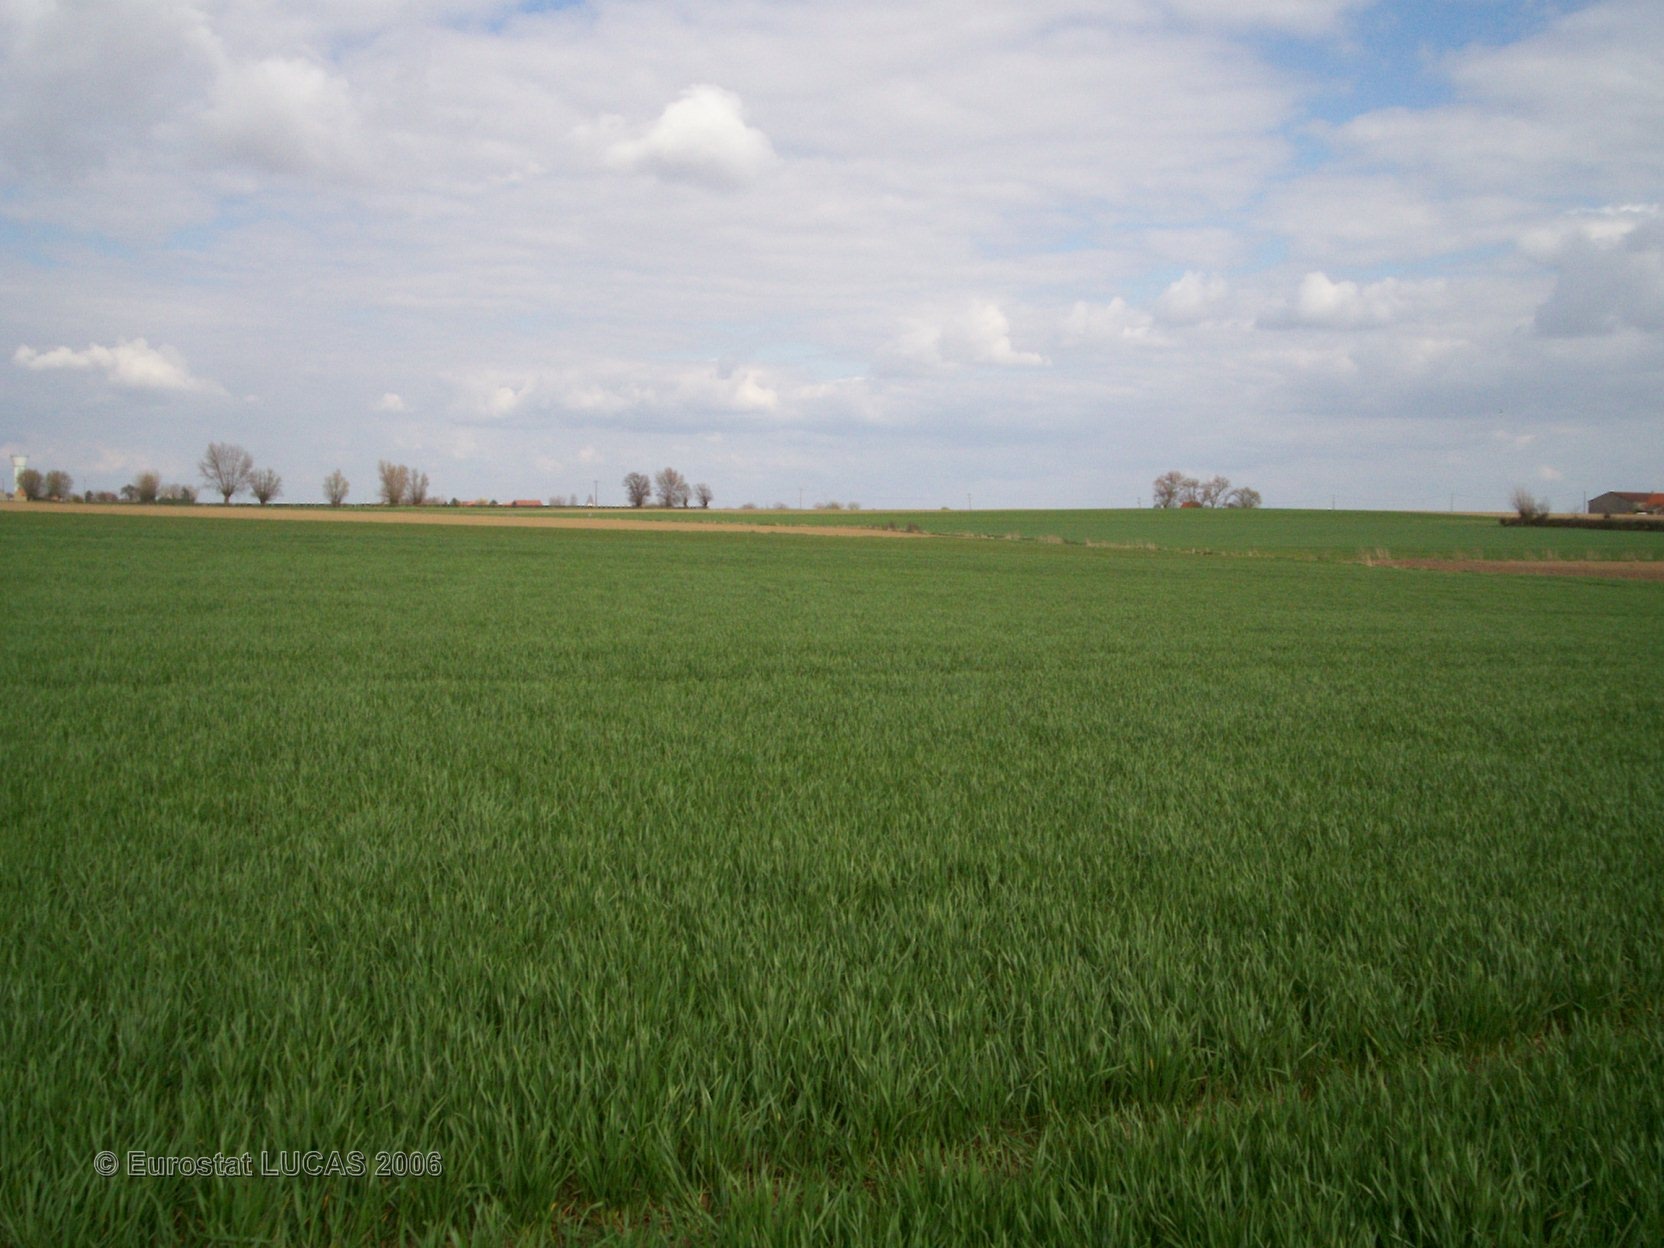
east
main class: Cropland
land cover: Common wheat
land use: Agriculture (excluding fallow land and kitchen gardens)
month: April
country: FR
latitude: 50.8846
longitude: 2.3532
